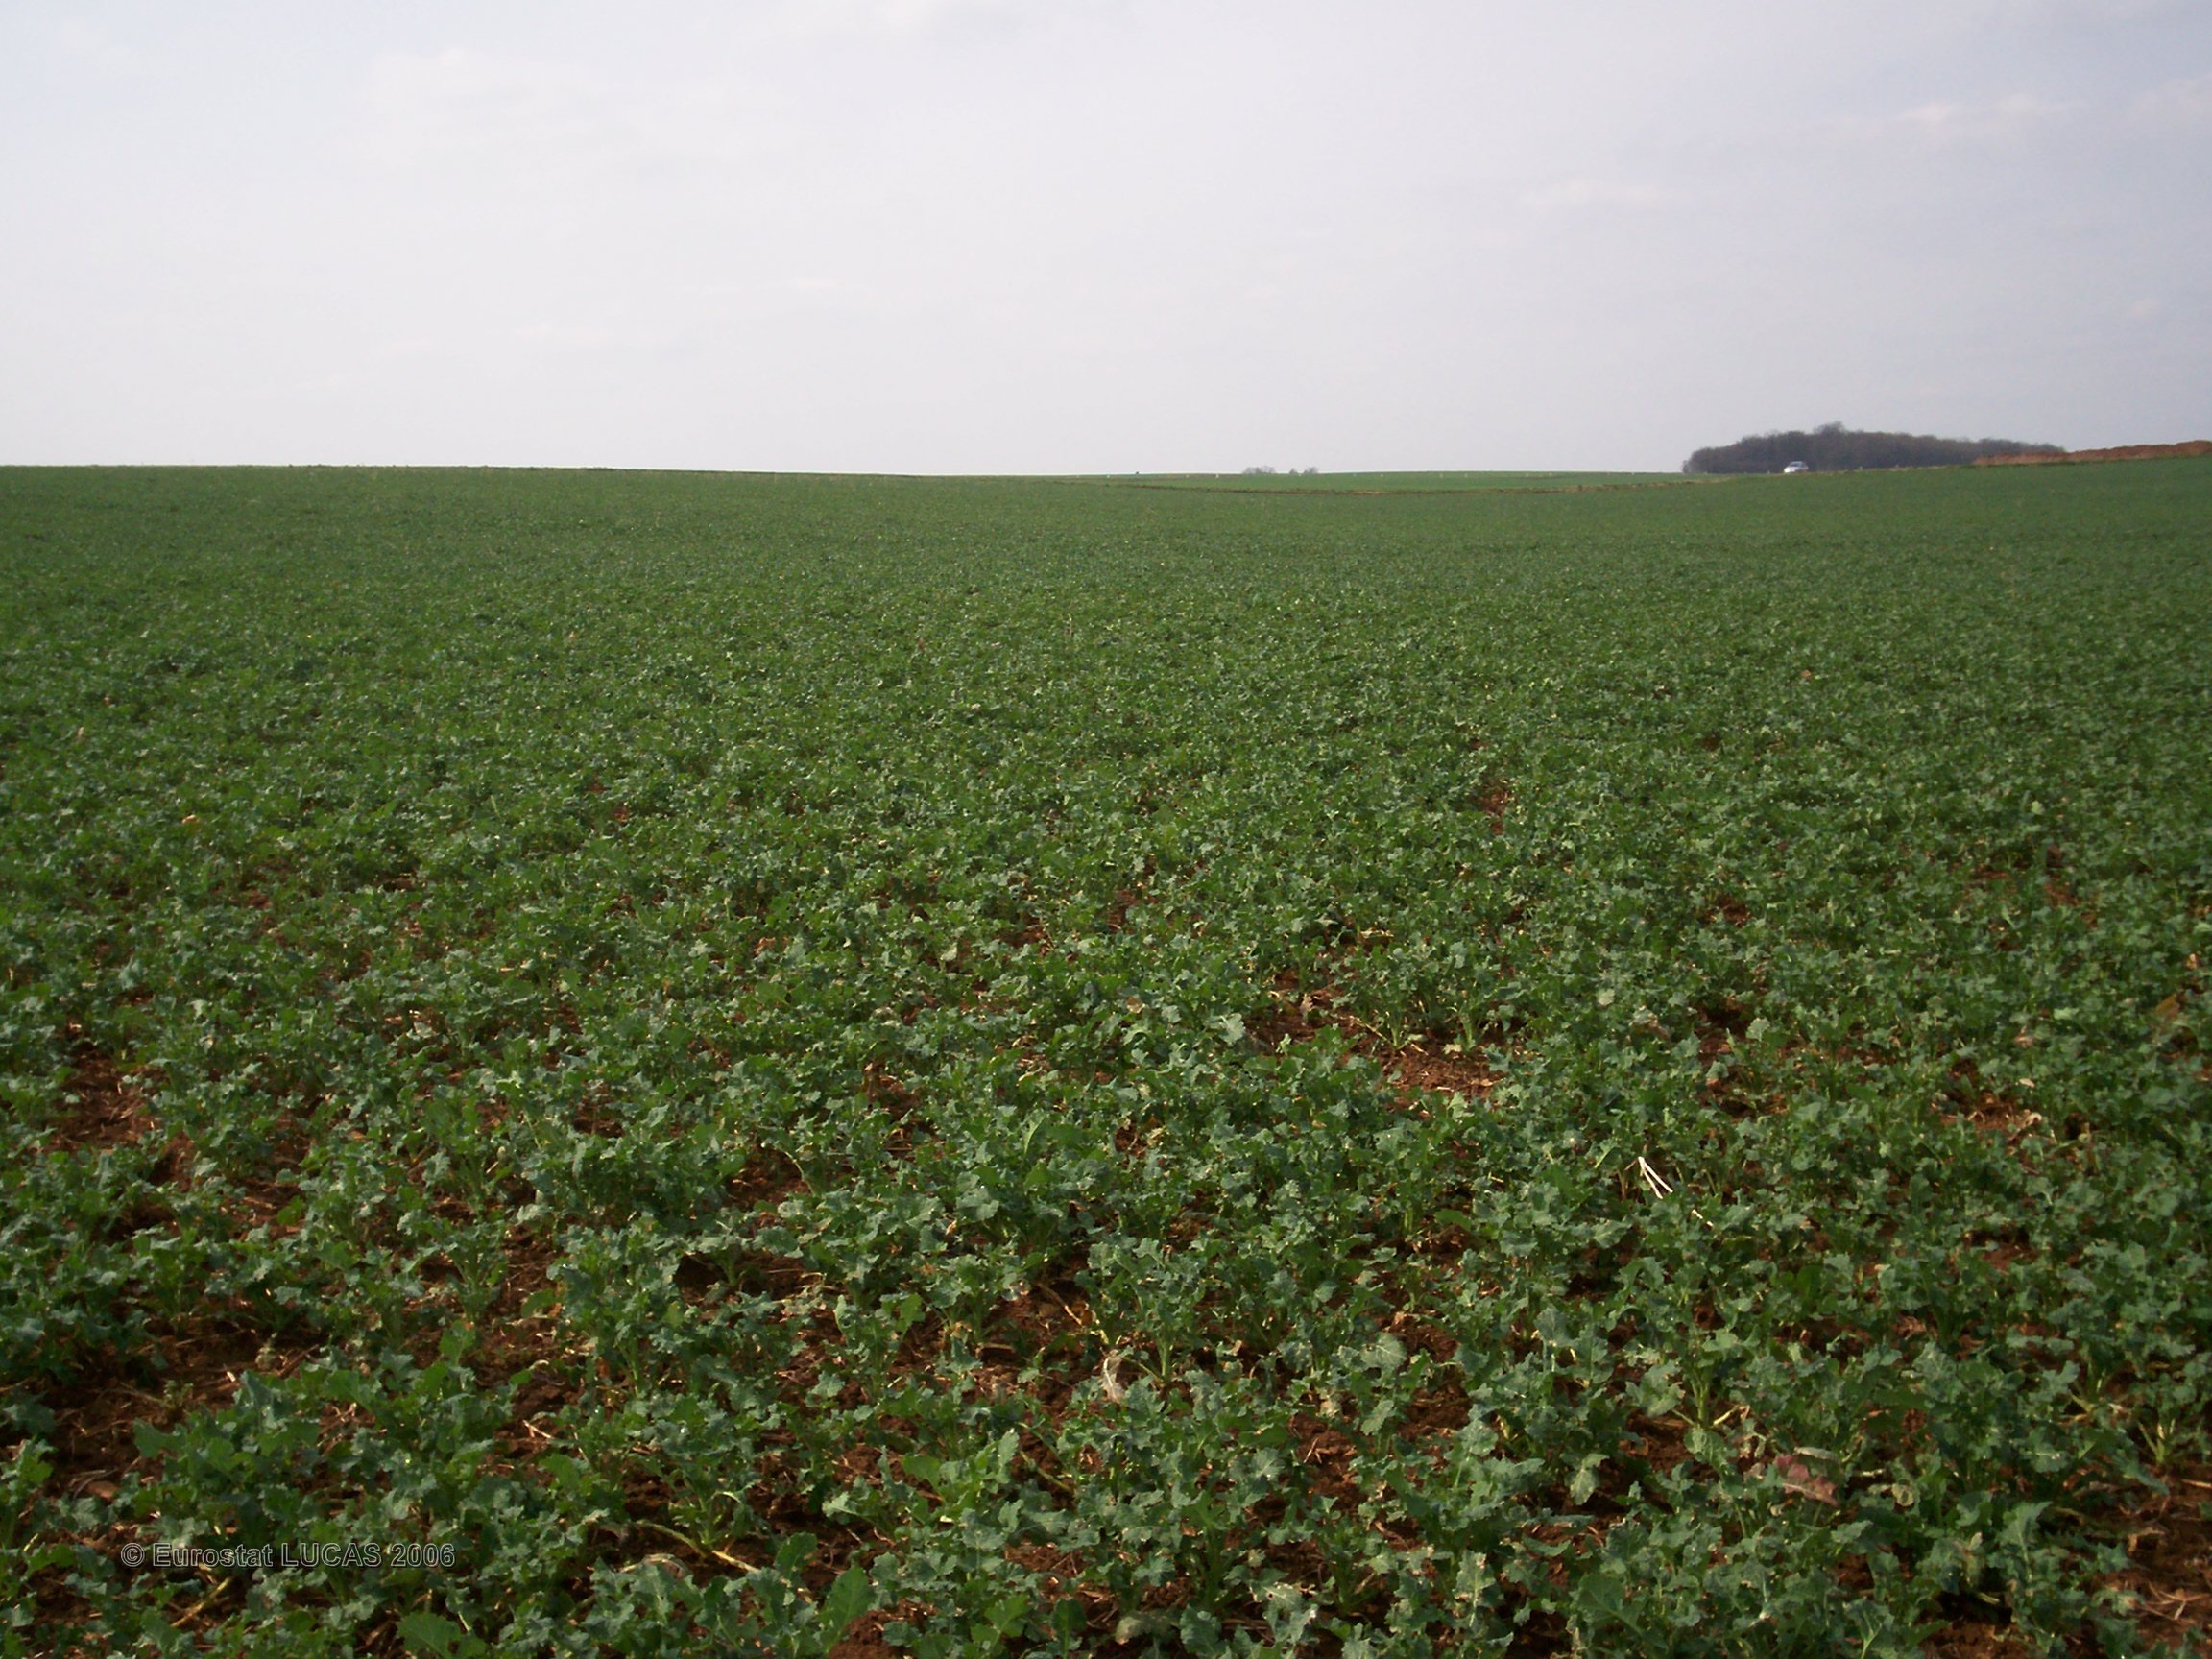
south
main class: Cropland
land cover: Rape and turnip rape
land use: Agriculture (excluding fallow land and kitchen gardens)
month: April
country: FR
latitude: 47.8163
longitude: 5.2855
